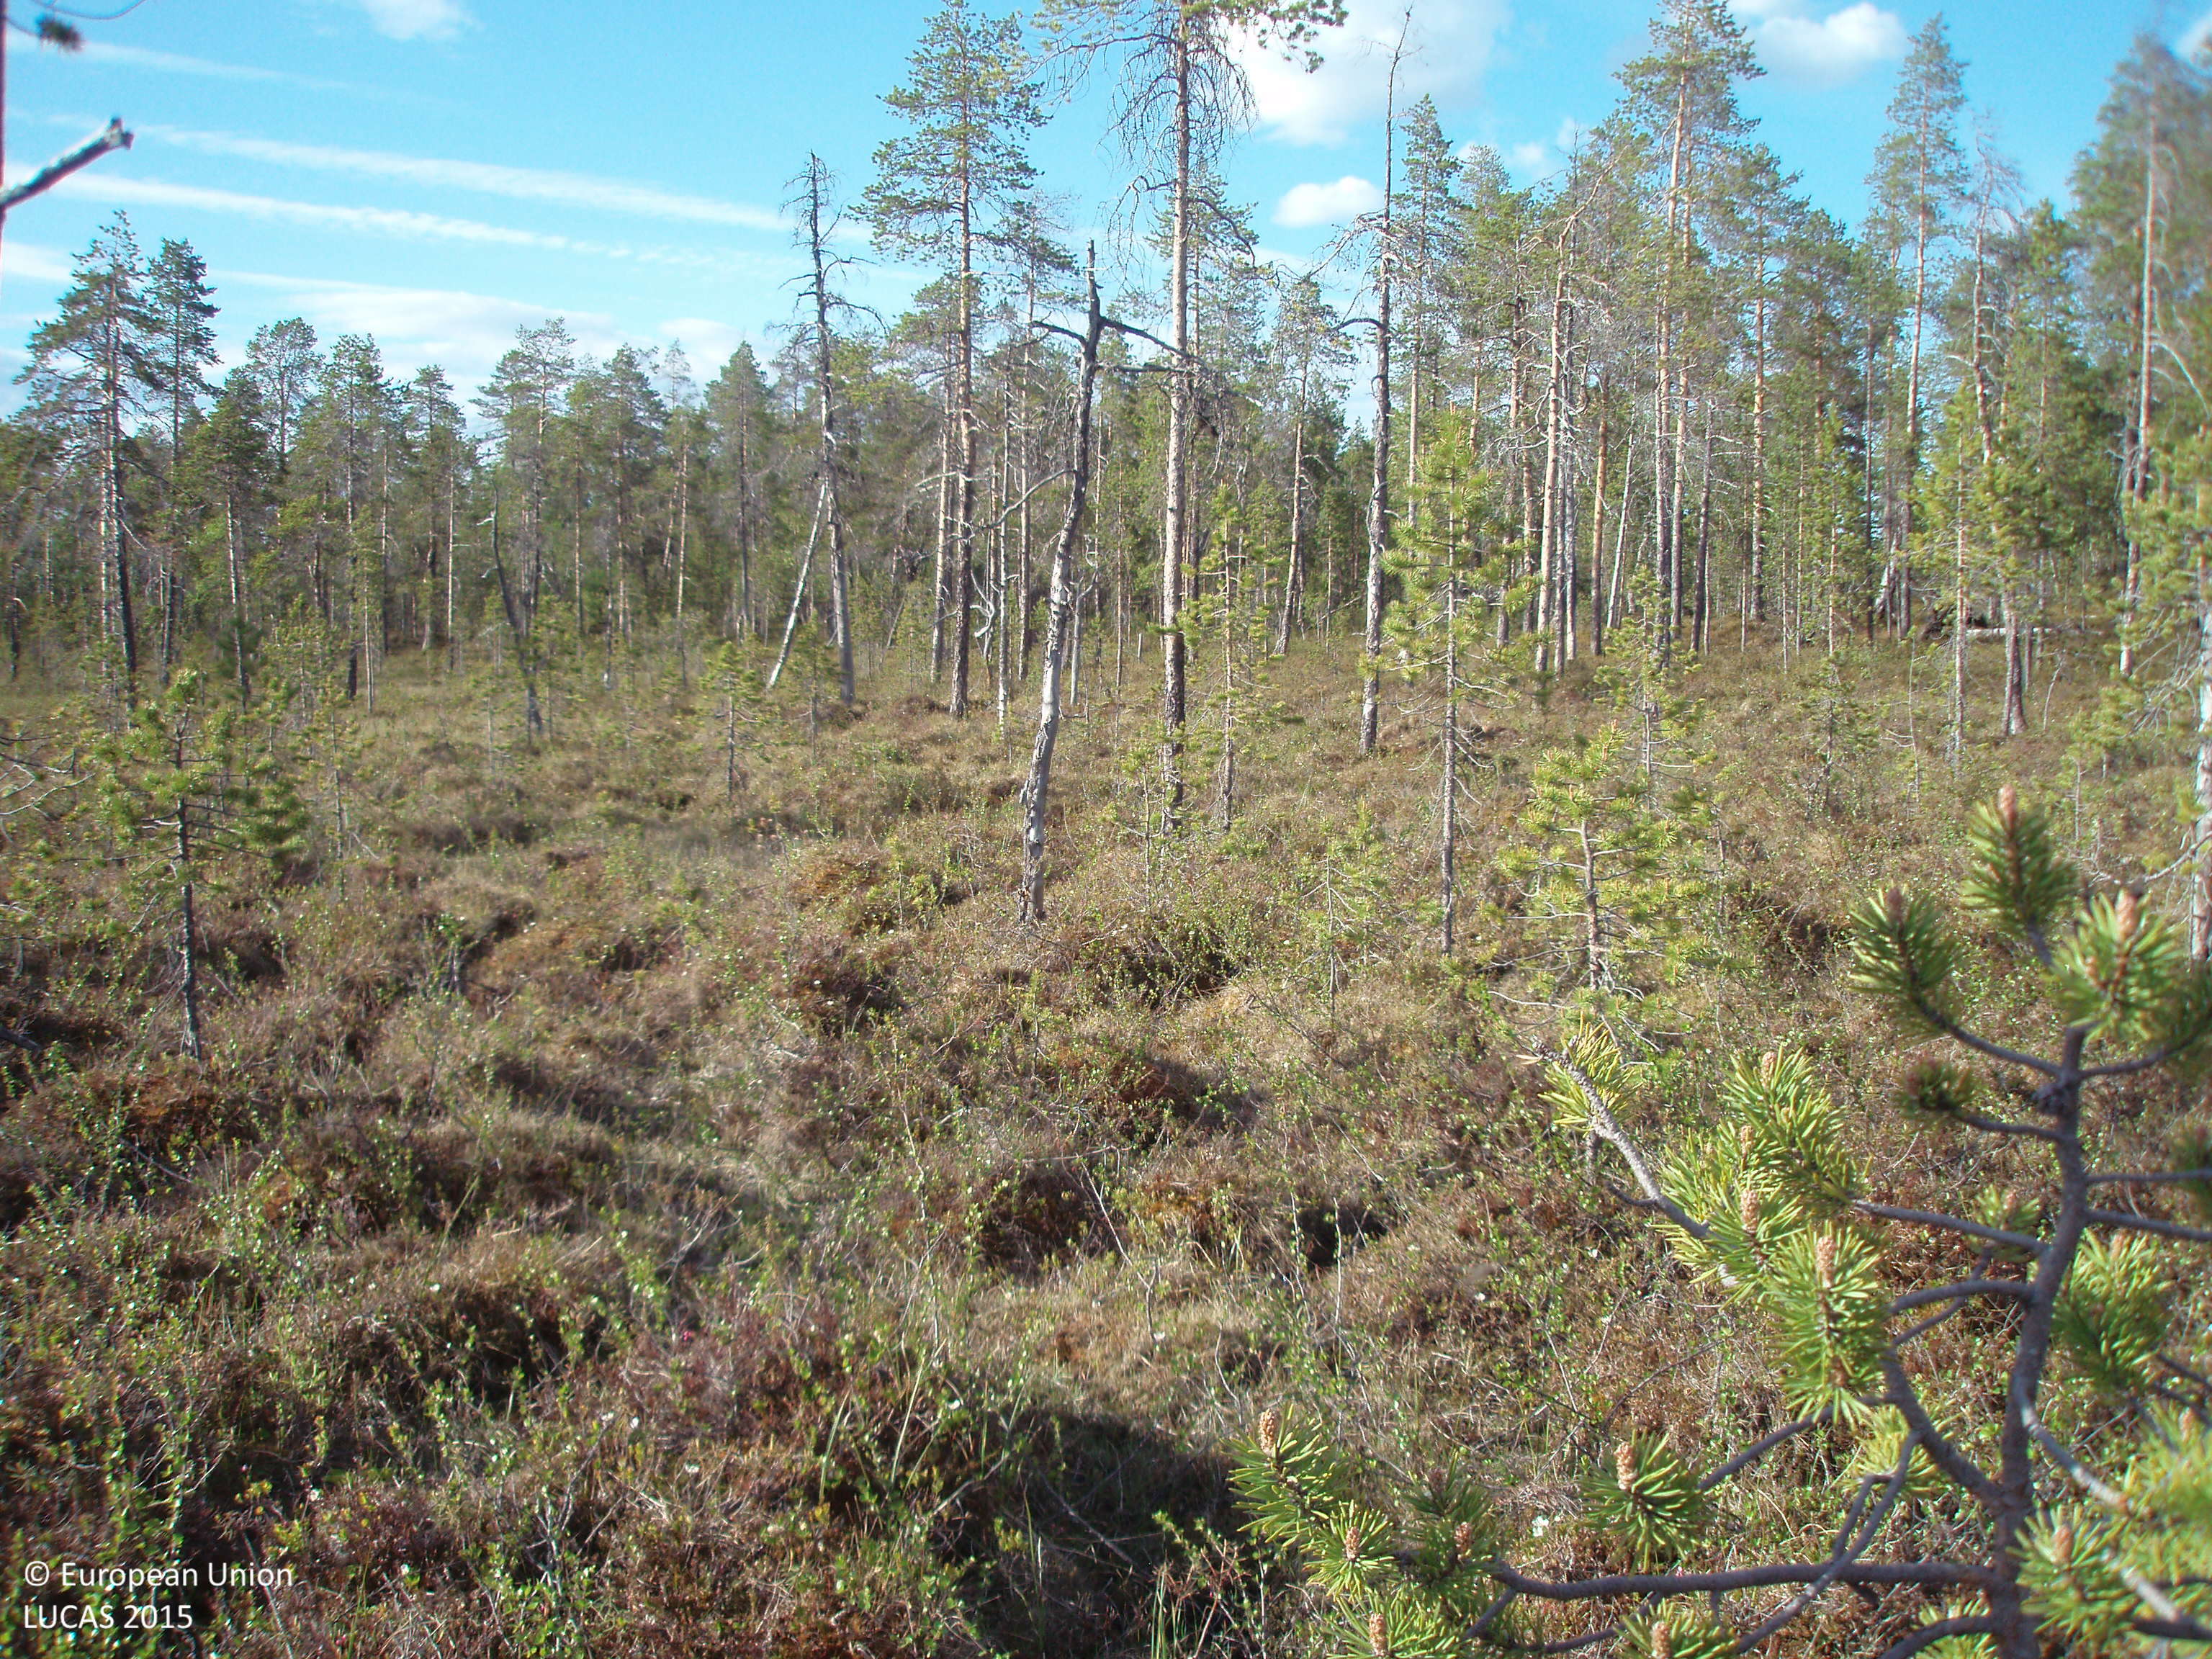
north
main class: Woodland
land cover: Pine dominated coniferous woodland
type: boreal forest
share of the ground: 25 - 50 %
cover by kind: shrubs 60 %, coniferous forest trees 30 %, lichens and mosses 10 %
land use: Semi-natural and natural areas not in use
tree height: > 5 m
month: June
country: FI
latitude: 68.7625
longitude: 28.5350
